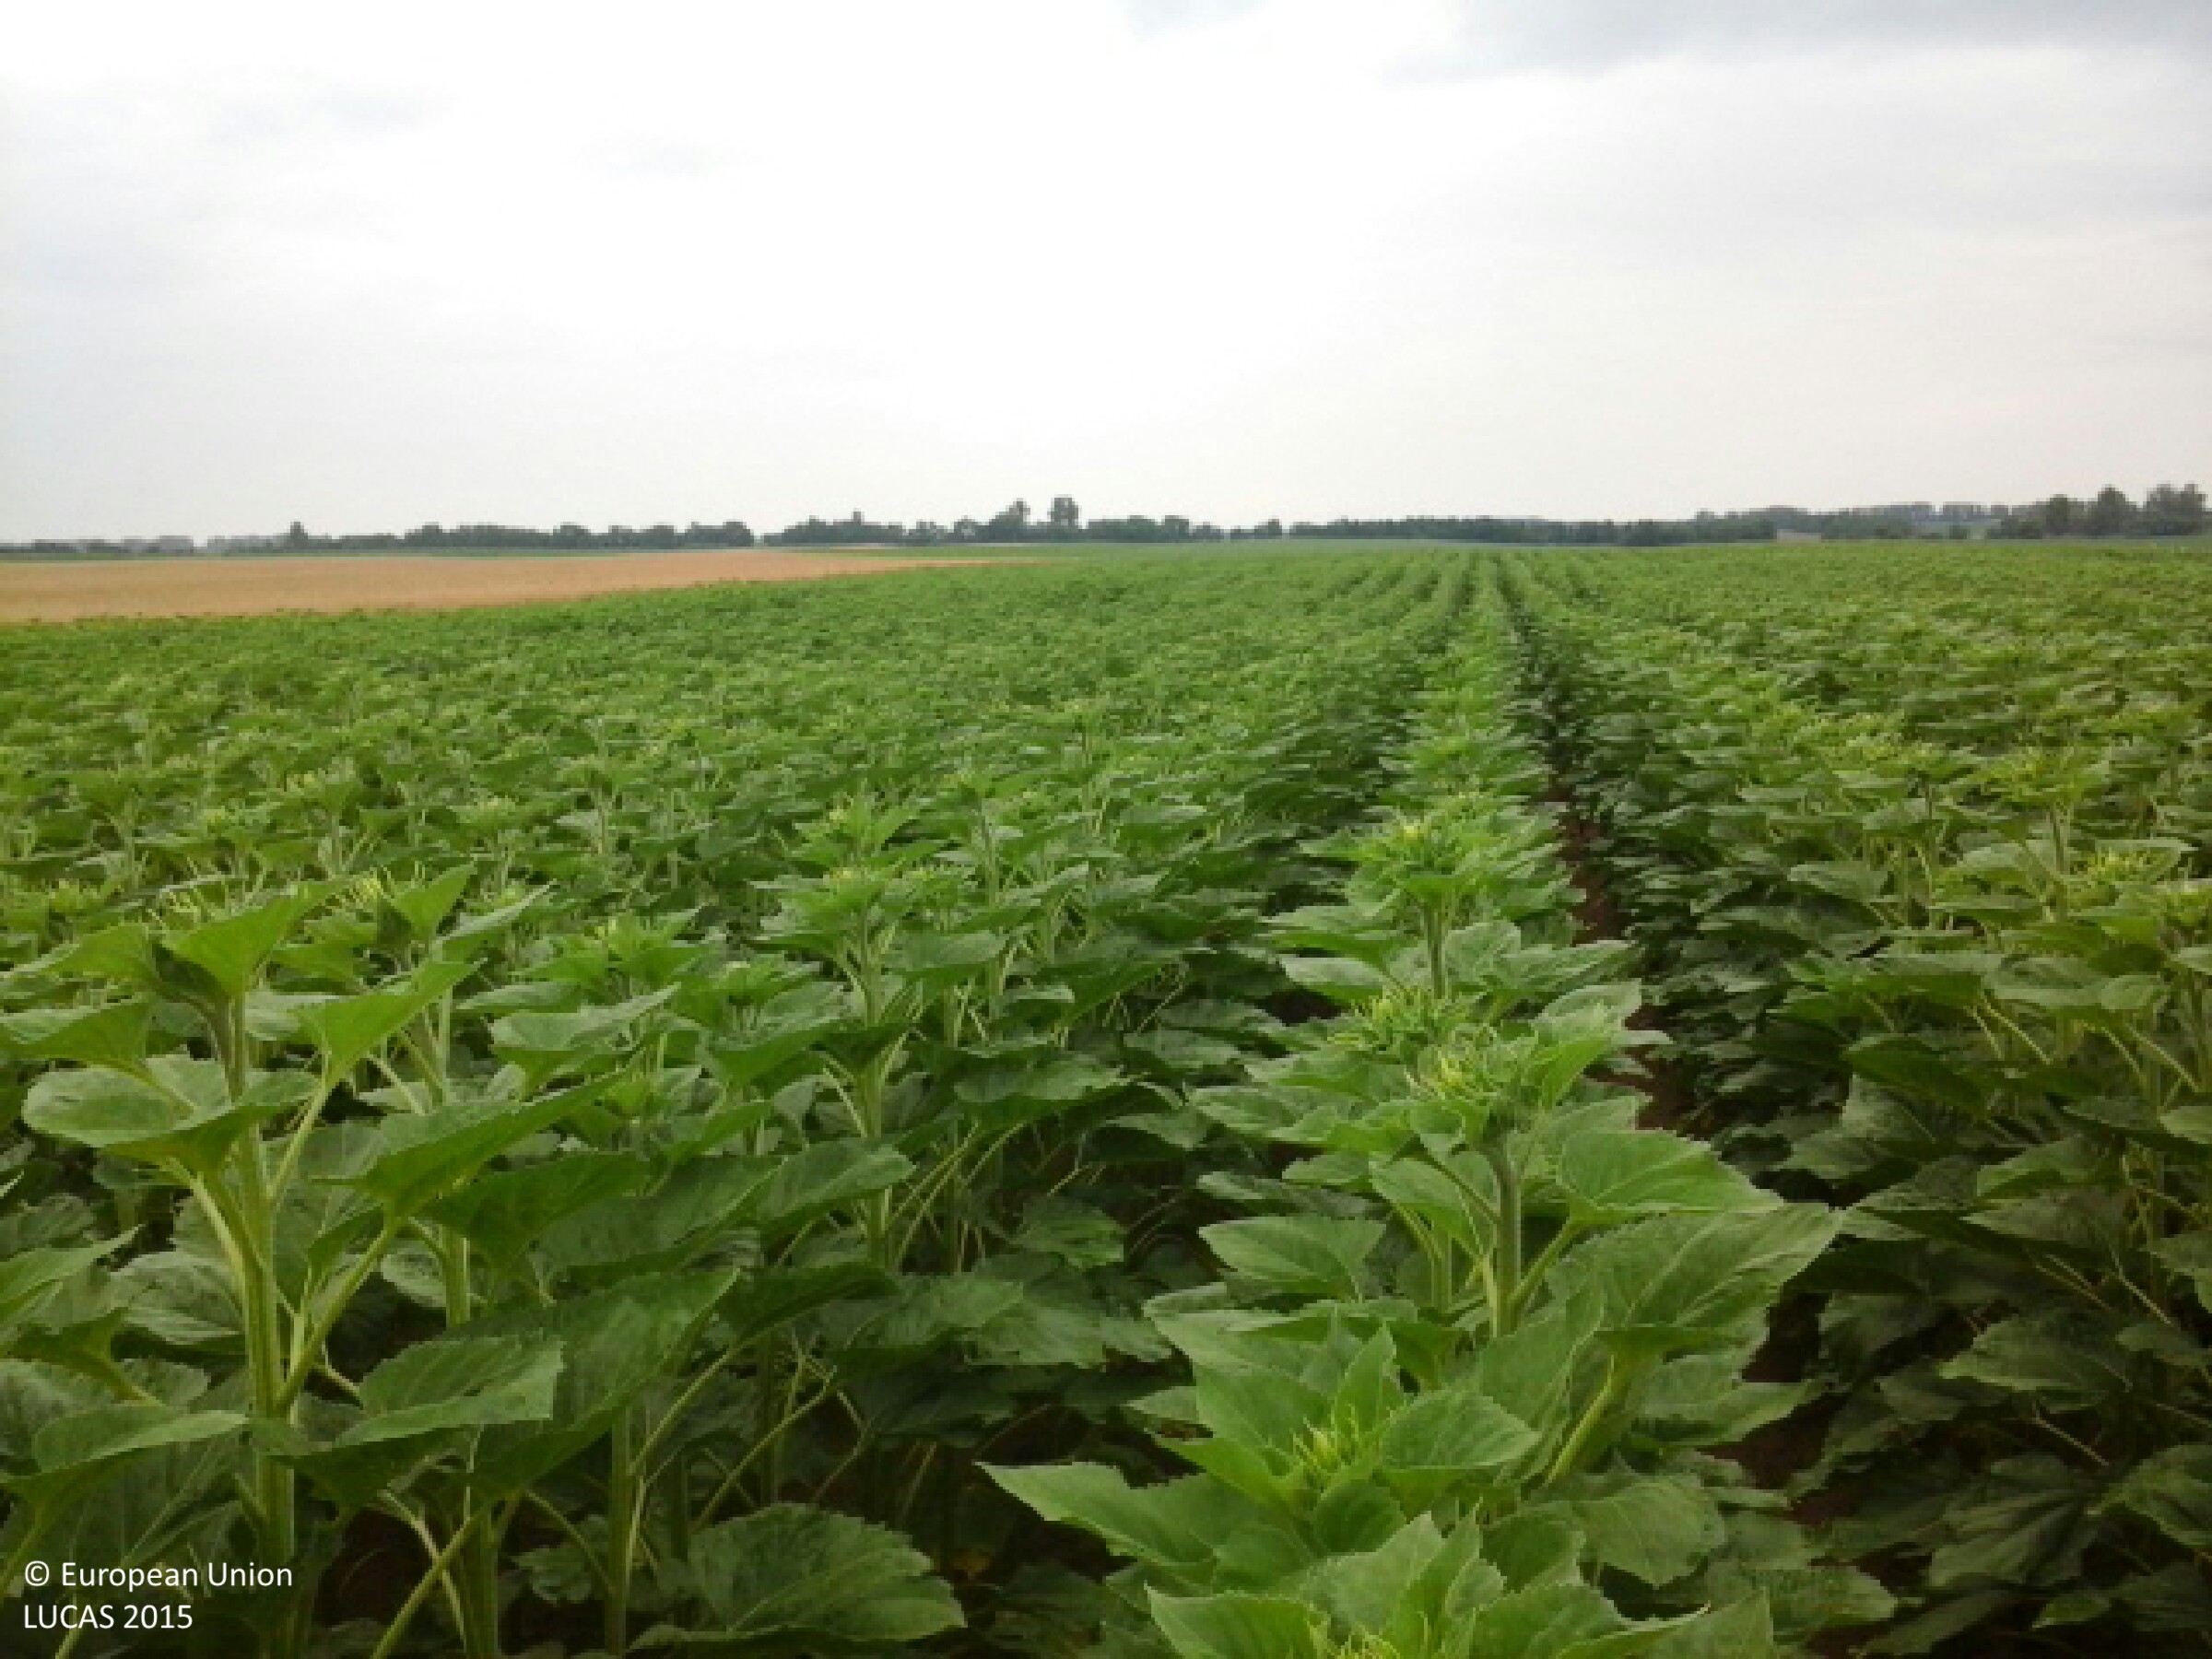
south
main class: Cropland
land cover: Sunflower
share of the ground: > 75 %
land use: Agriculture (excluding fallow land and kitchen gardens)
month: June
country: HU
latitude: 48.1604
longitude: 21.5411
